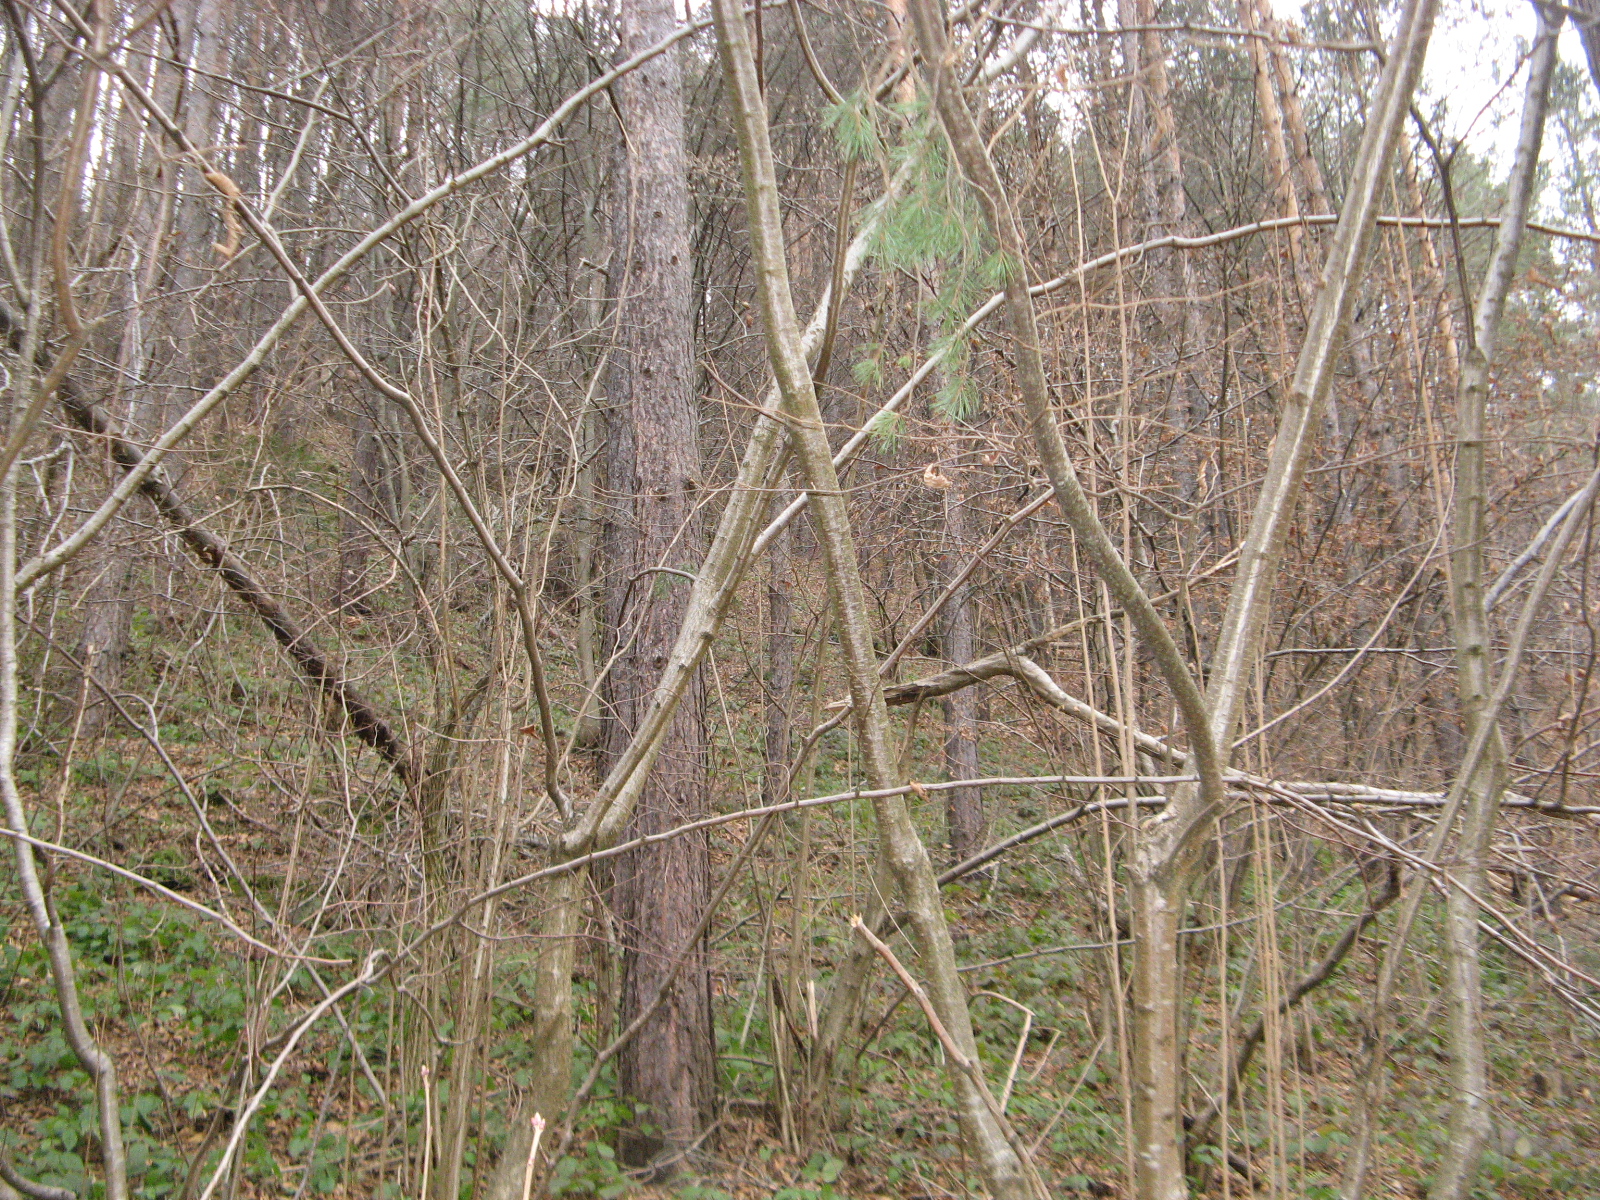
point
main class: Woodland
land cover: Pine dominated mixed woodland
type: hemiboreal forest and nemoral coniferous forest and mixed broadleaved-coniferous forest
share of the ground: > 75 %
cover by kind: coniferous forest trees 60 %, broadleaved forest trees 30 %, herbaceous plants 5 %, unconsolidated bare surface 5 %
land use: Forestry
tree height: > 5 m
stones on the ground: < 10 %
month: December
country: BG
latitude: 41.9534
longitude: 24.2398
